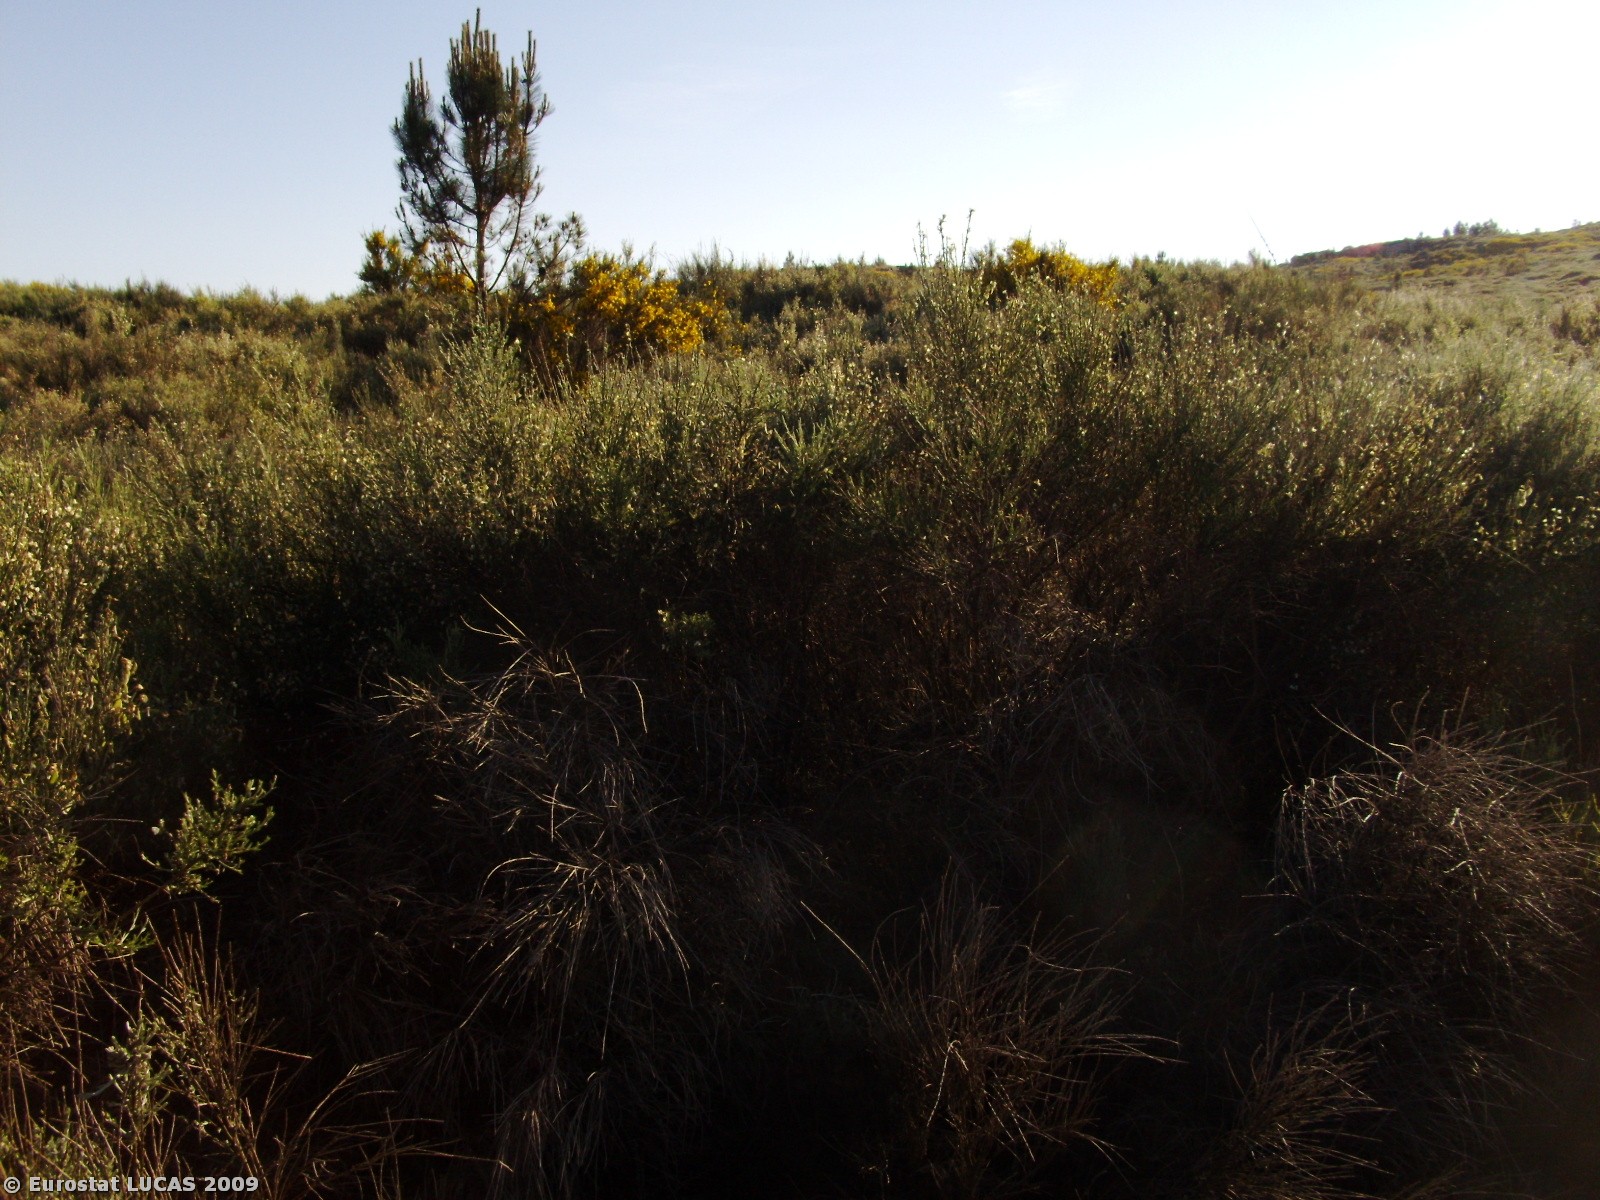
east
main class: Shrubland
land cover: Shrubland with sparse tree cover
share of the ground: > 75 %
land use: Fallow land
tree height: > 5 m
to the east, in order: Shrubland with sparse tree cover; Rock outcrops; Shrubland with sparse tree cover
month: May
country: PT
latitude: 41.0107
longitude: -7.3691
